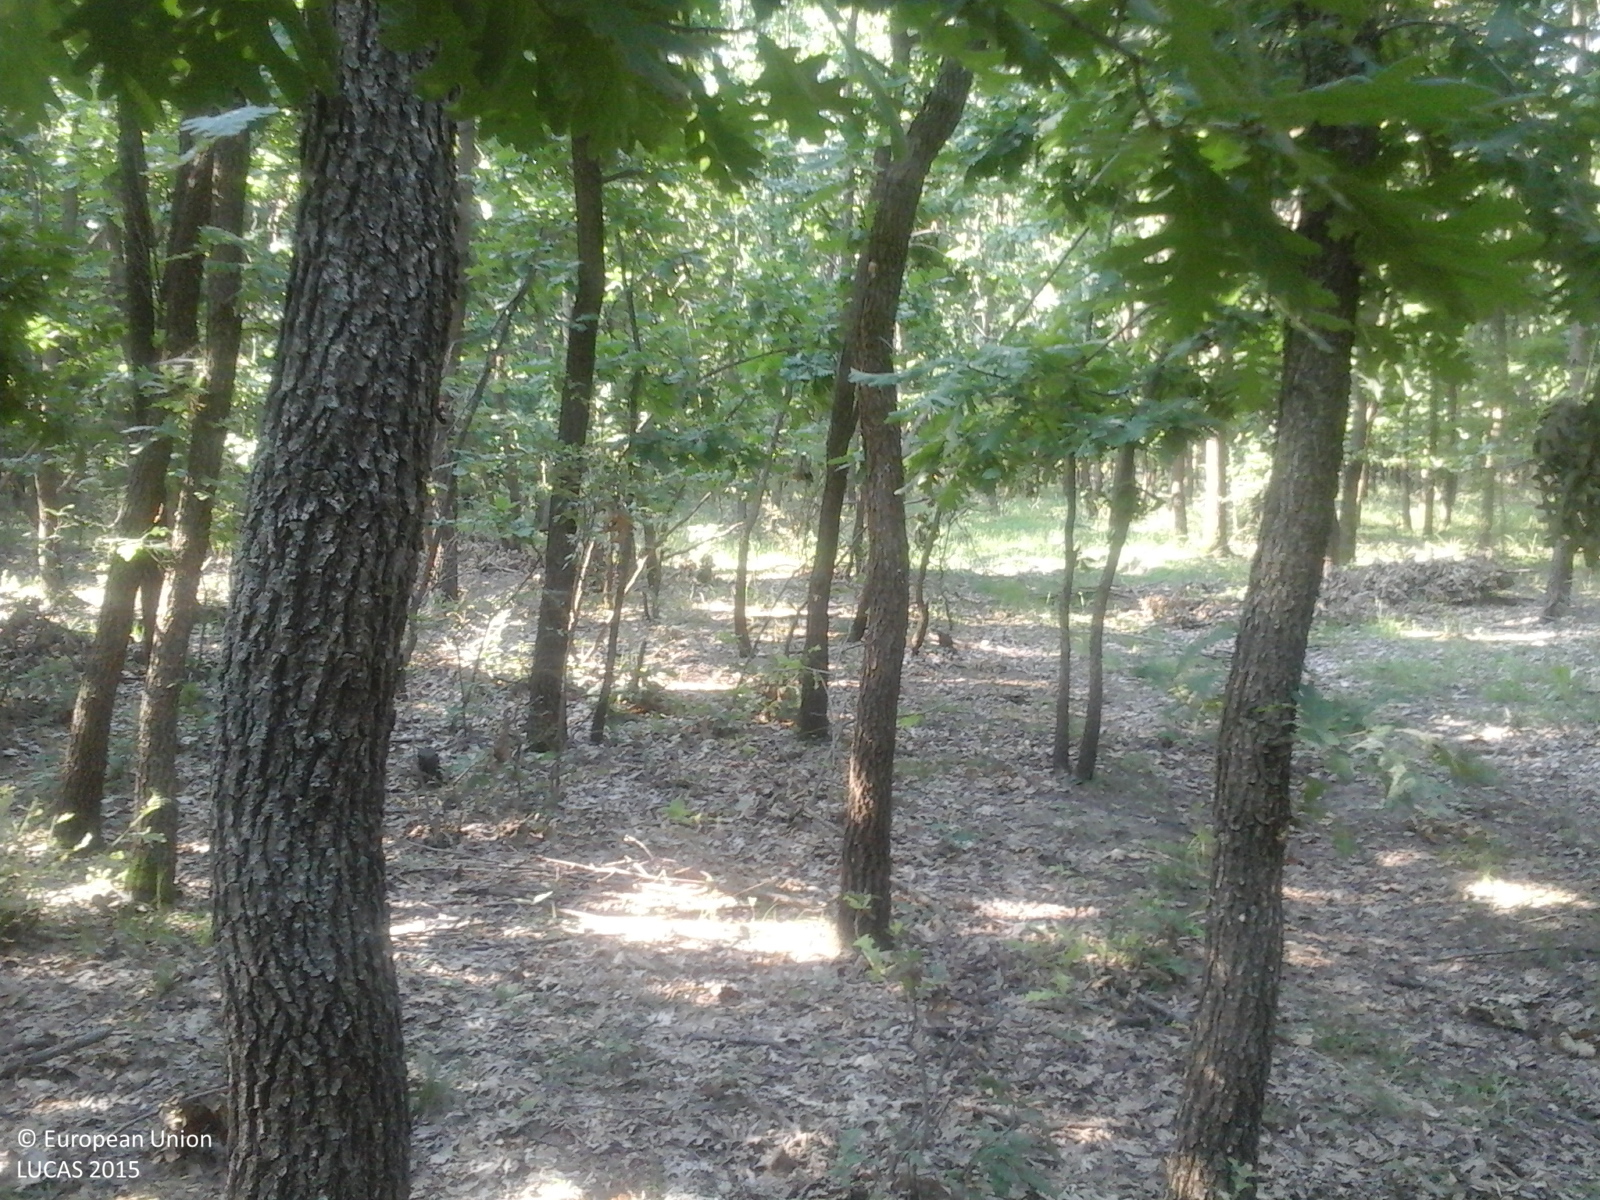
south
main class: Woodland
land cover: Broadleaved woodland
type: acidophilous oak and oak-birch forest
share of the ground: > 75 %
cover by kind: broadleaved forest trees 100 %
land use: Forestry
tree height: > 5 m
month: July
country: RO
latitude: 44.5258
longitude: 24.8116
